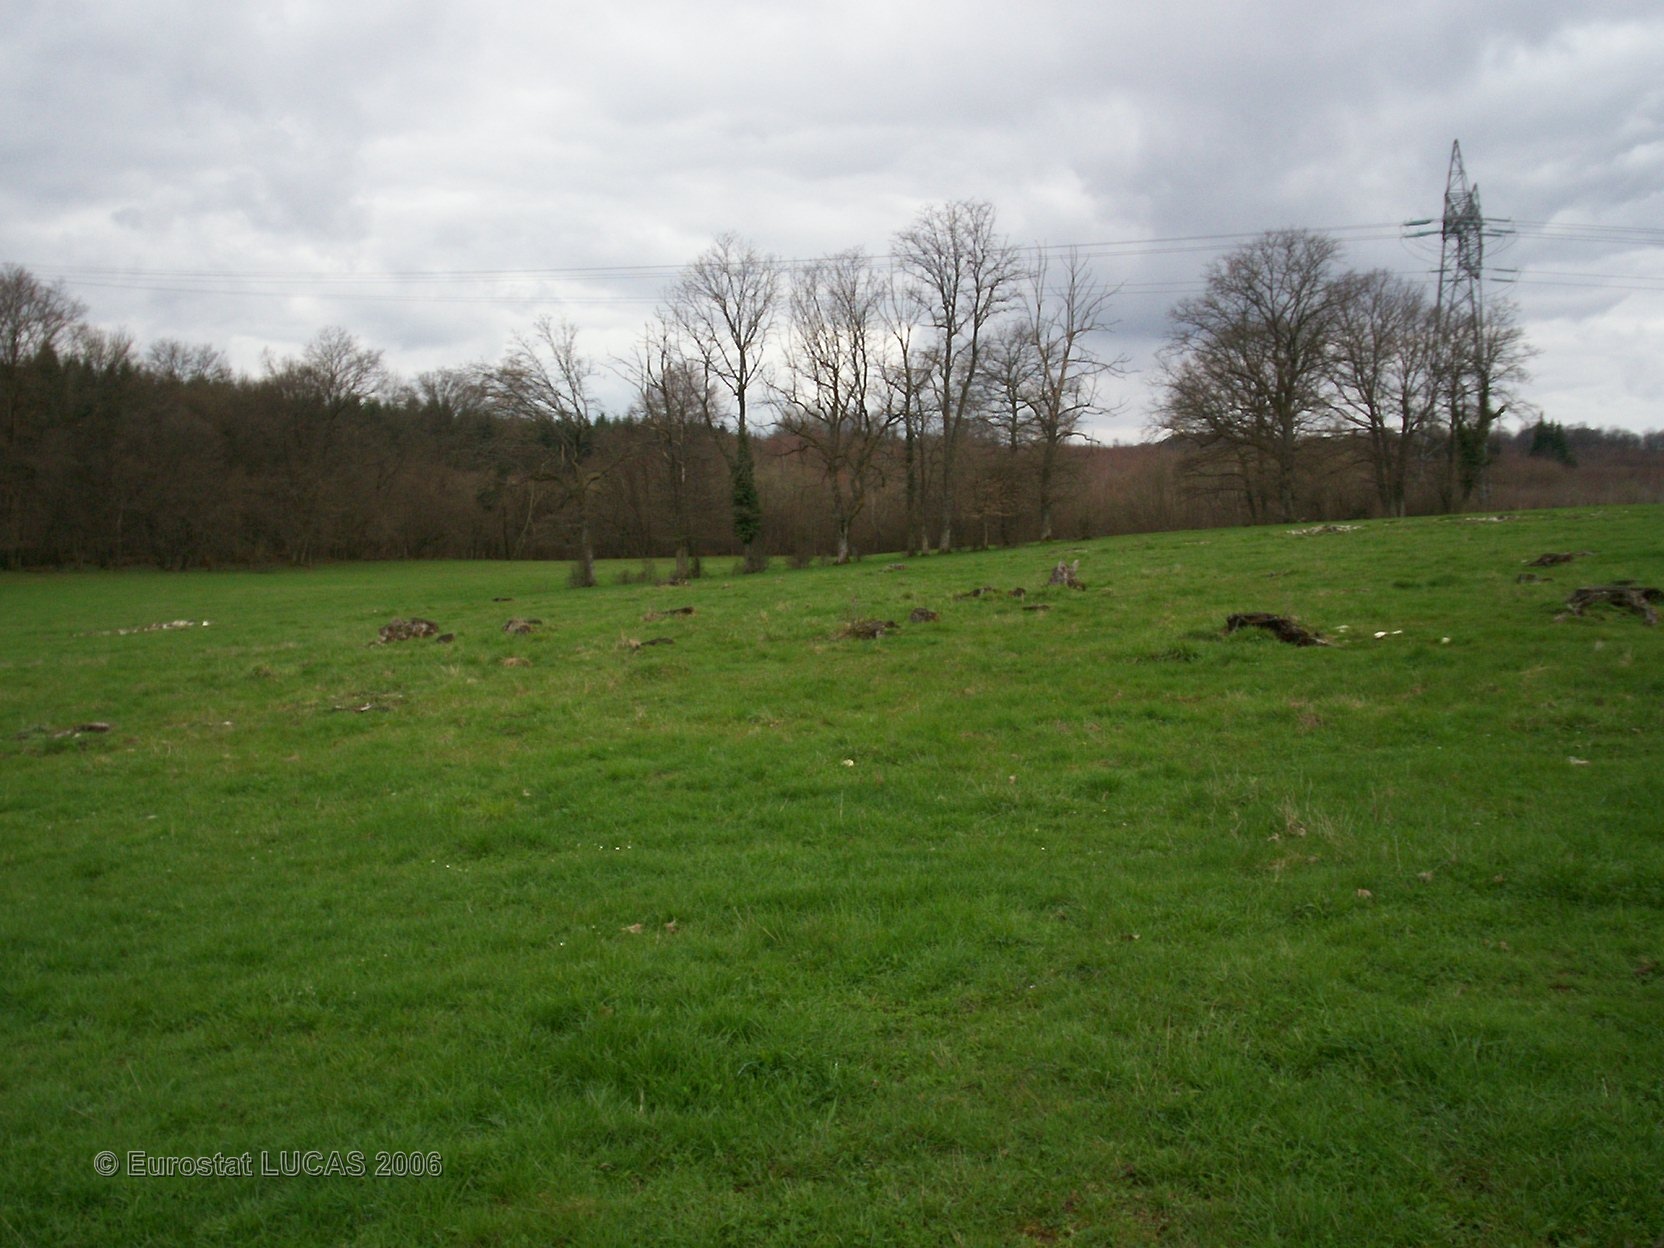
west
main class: Grassland
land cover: Grassland without tree/shrub cover
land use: Agriculture (excluding fallow land and kitchen gardens)
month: April
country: FR
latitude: 47.5647
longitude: 6.7984
